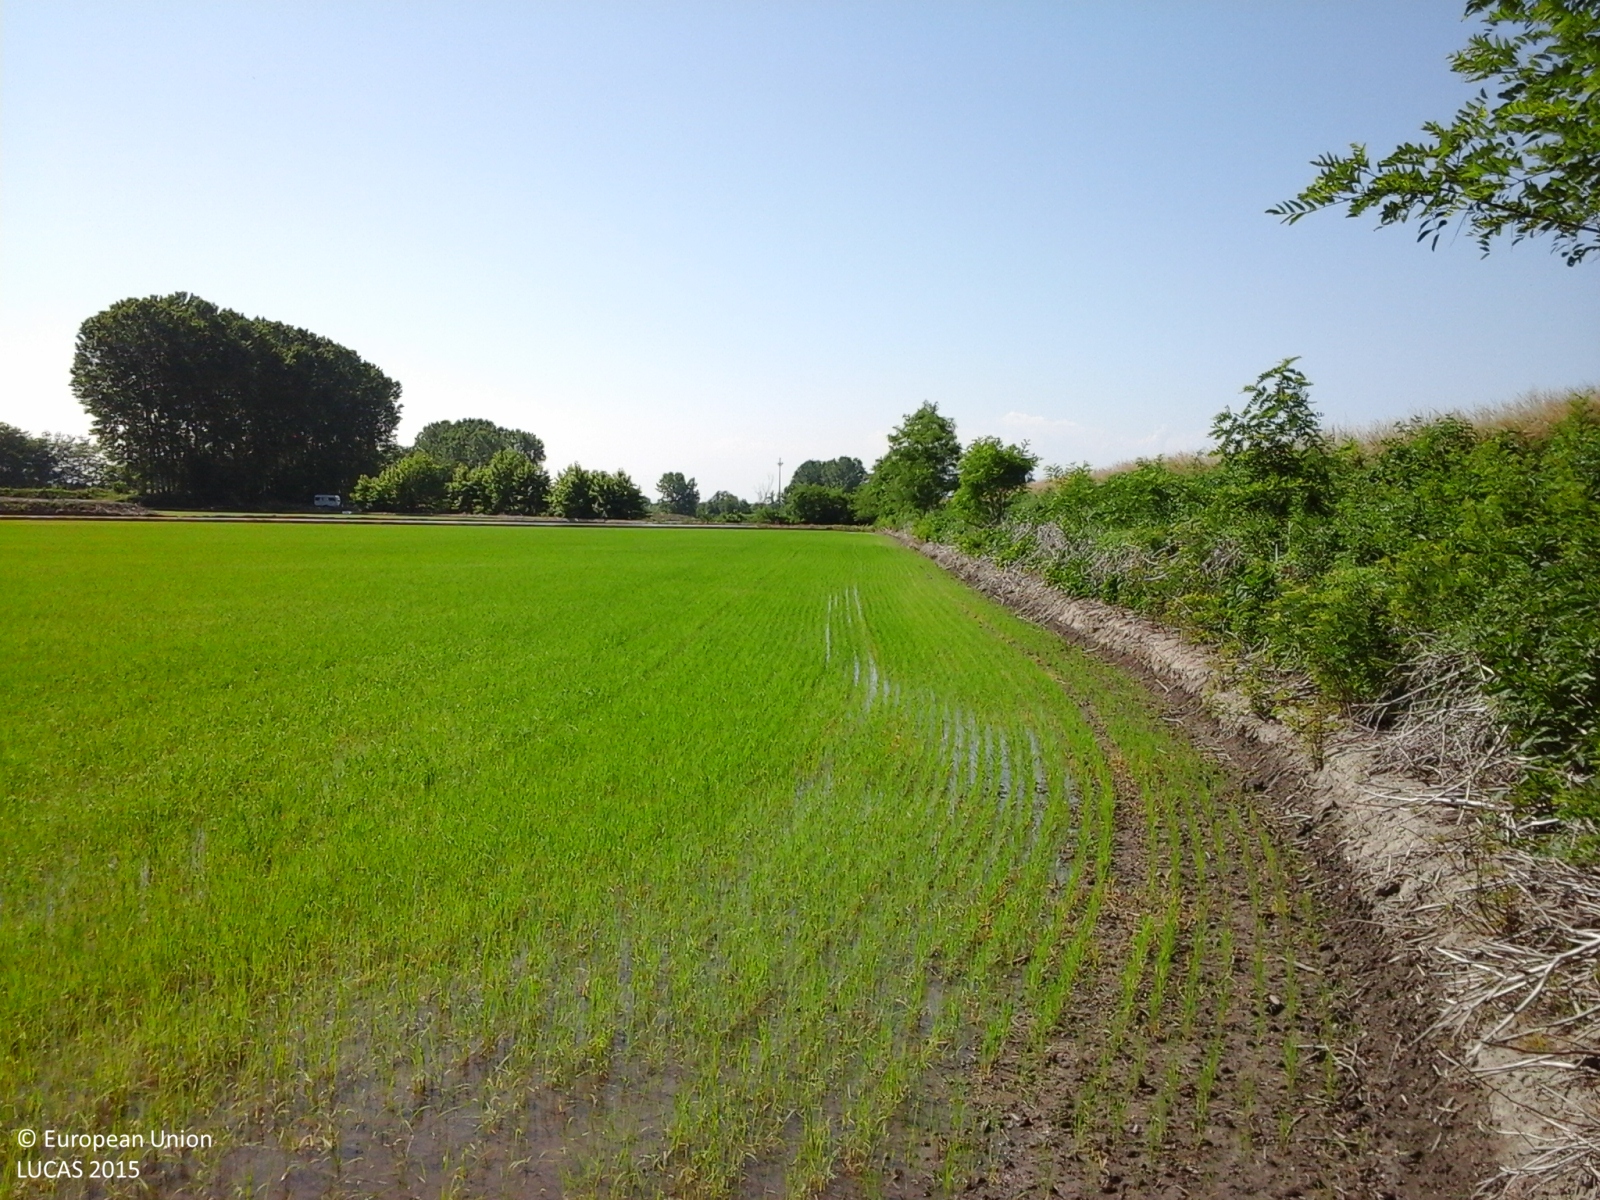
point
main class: Cropland
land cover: Rice
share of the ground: 50 - 75 %
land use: Agriculture (excluding fallow land and kitchen gardens)
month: May
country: IT
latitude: 45.2585
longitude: 8.4353
